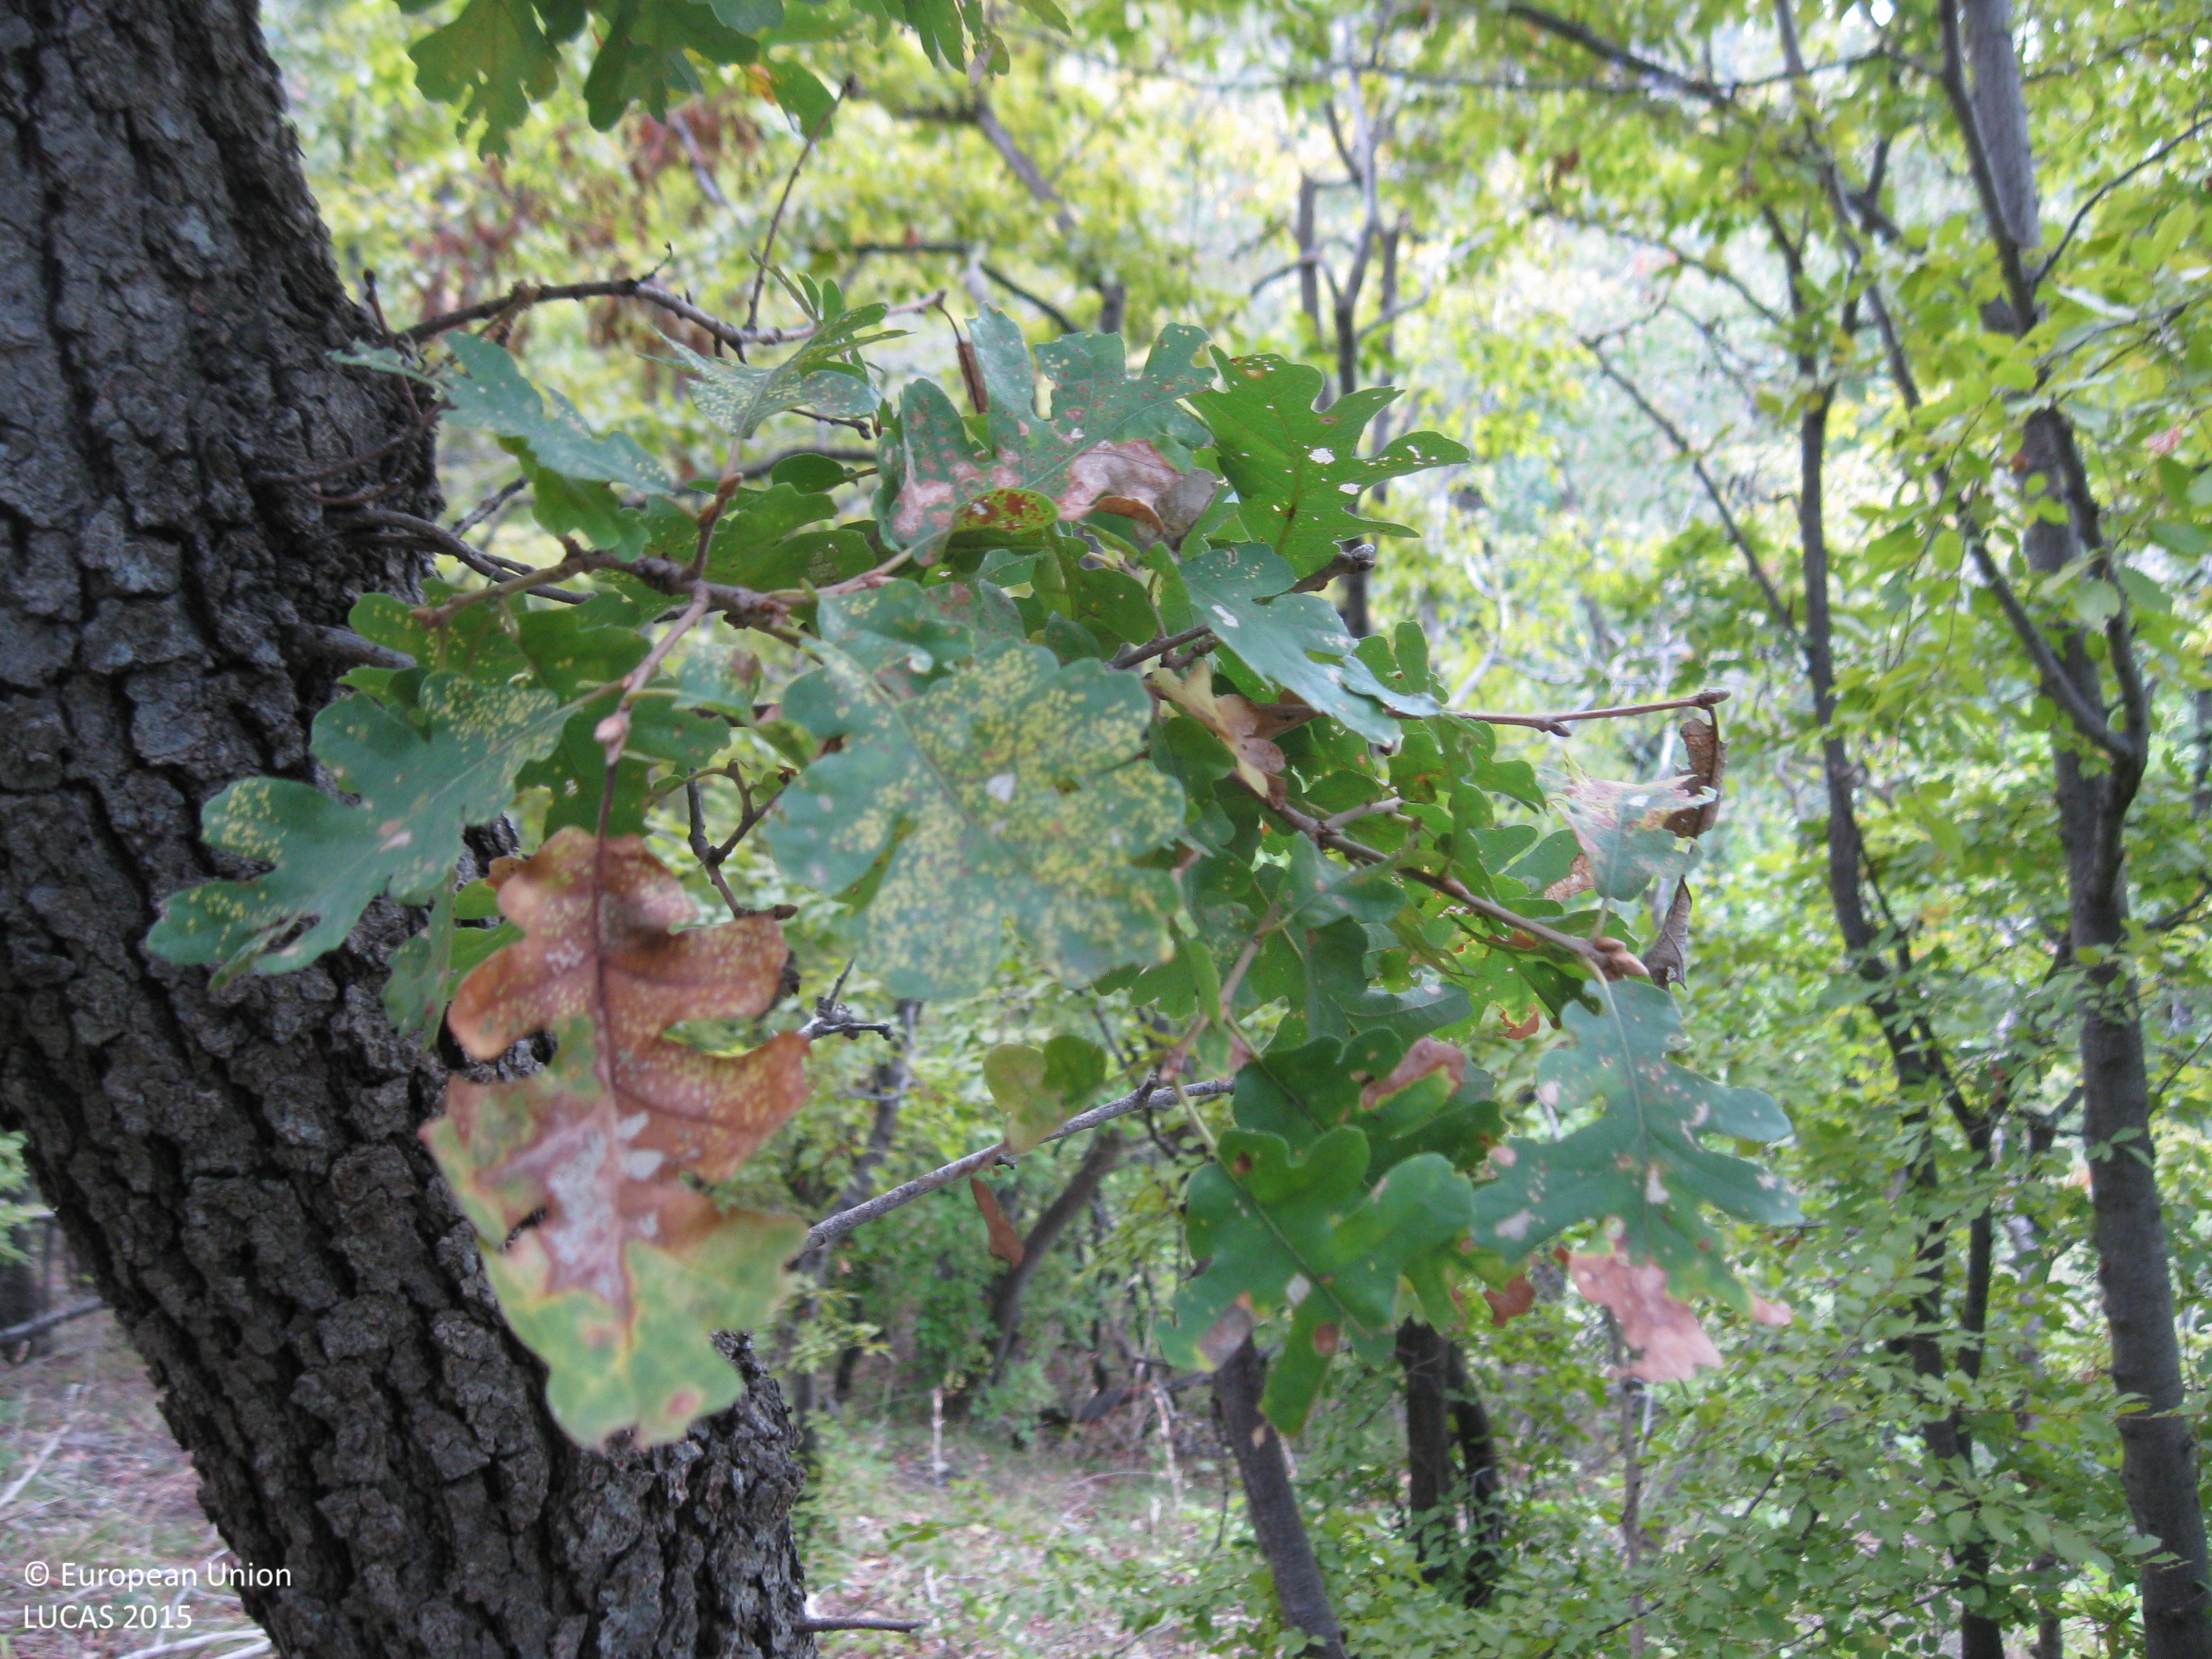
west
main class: Woodland
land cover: Broadleaved woodland
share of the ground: > 75 %
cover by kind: broadleaved forest trees 100 %
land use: Forestry
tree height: < 5 m
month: October
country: BG
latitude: 42.0505
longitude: 24.7054
